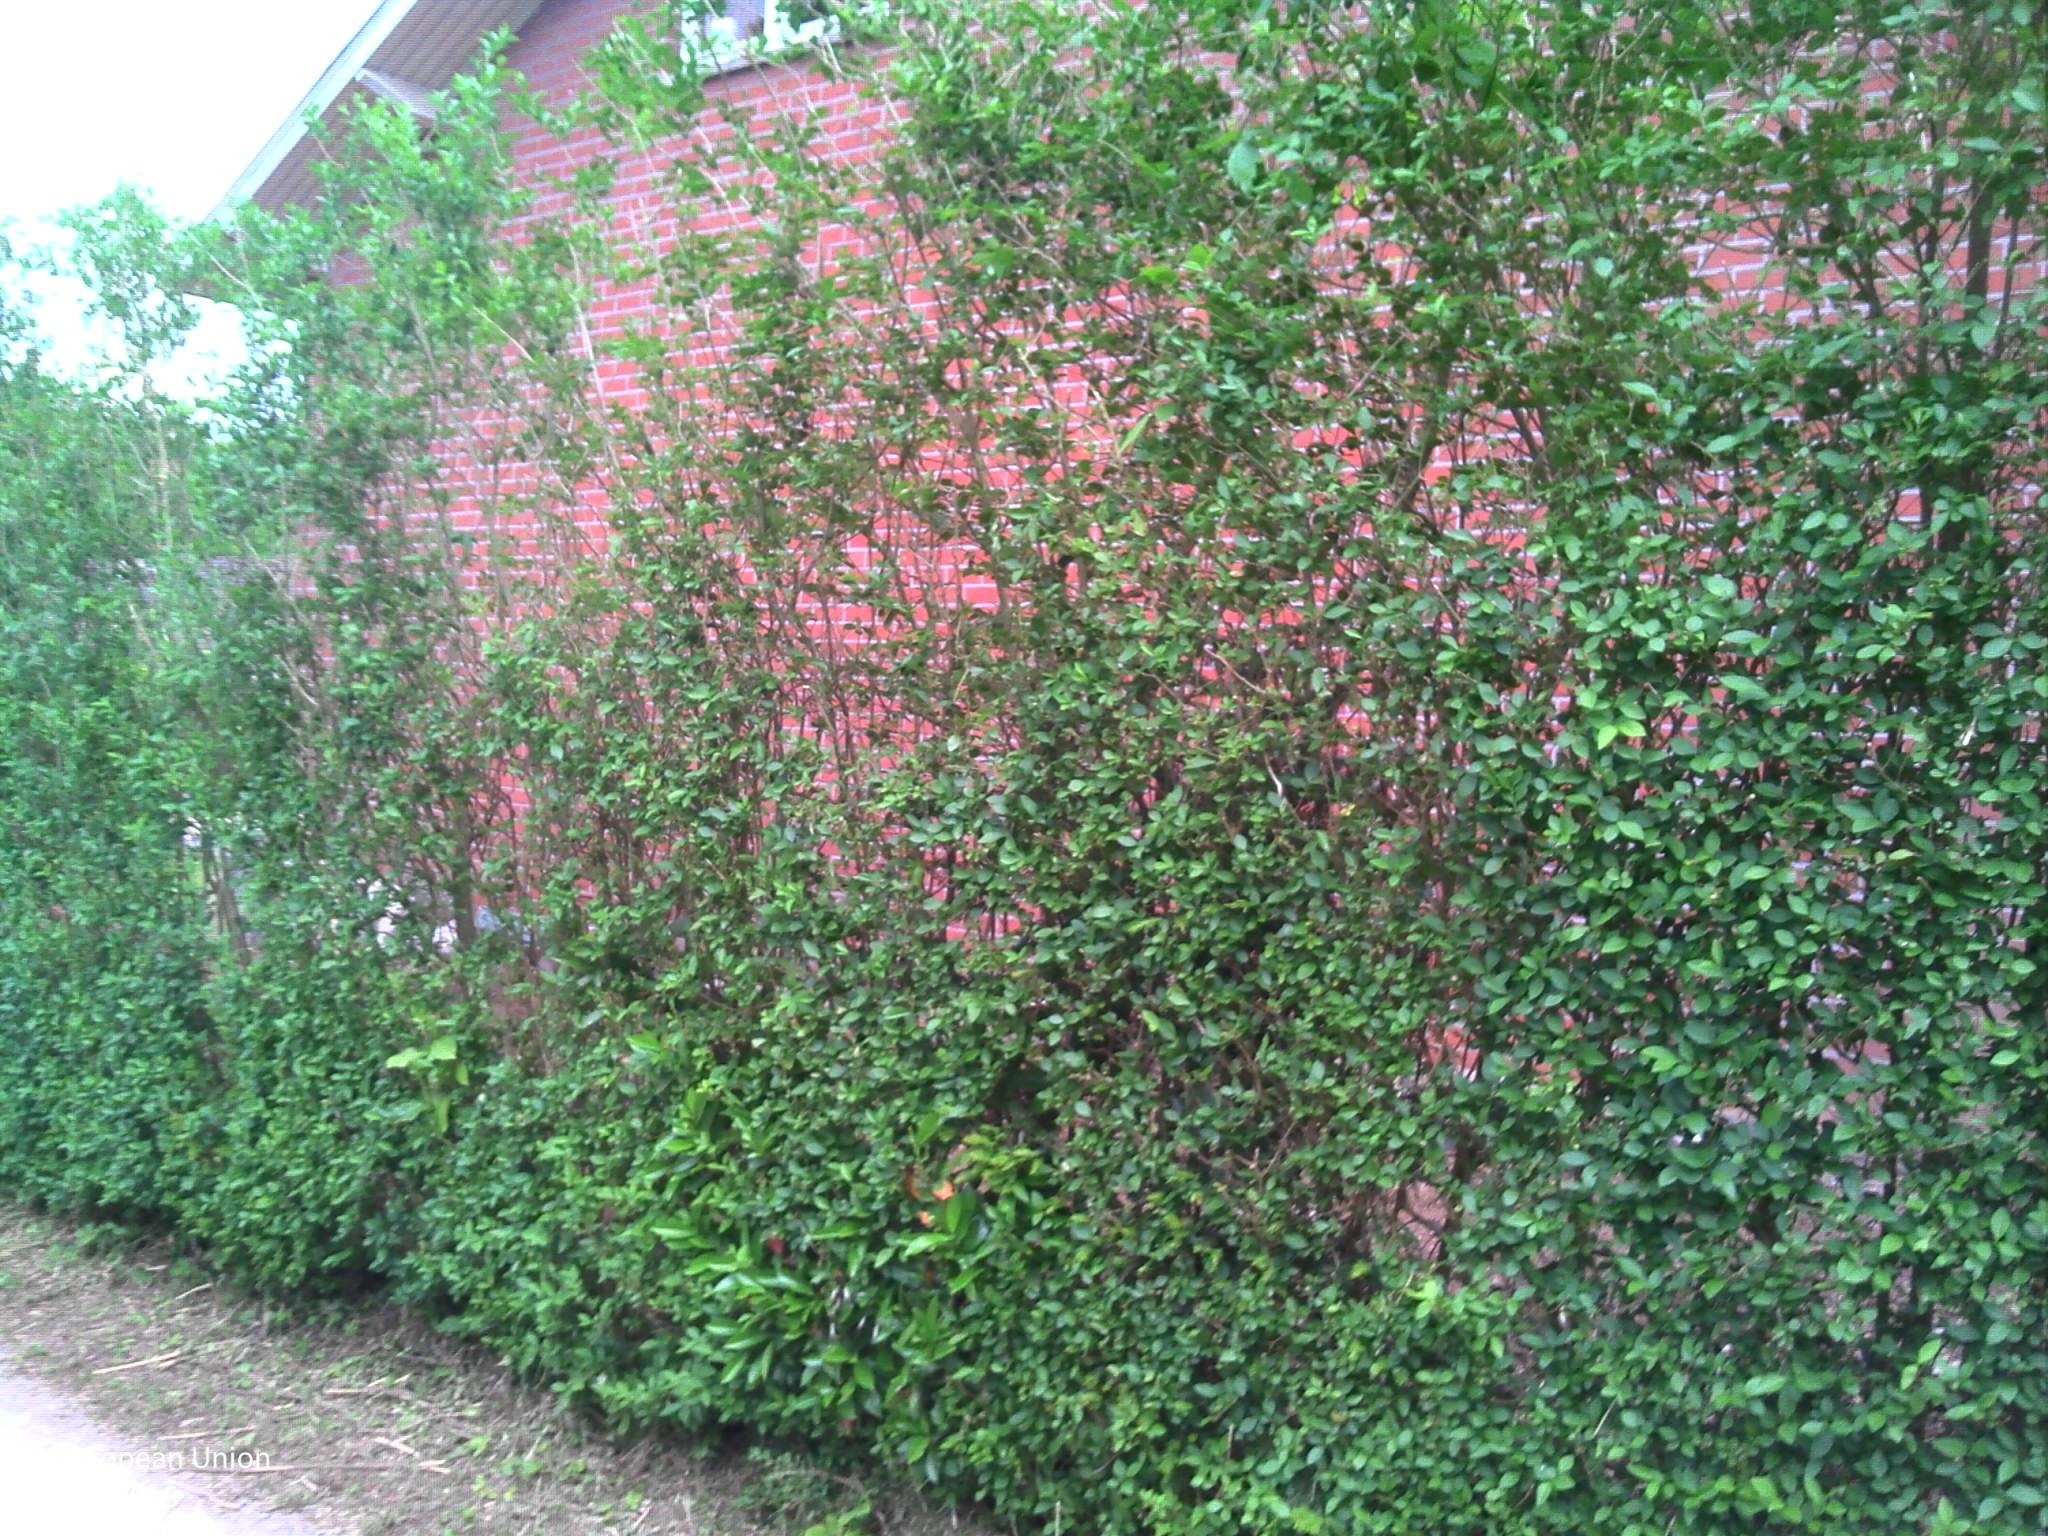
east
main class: Grassland
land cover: Grassland with sparse tree/shrub cover
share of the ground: > 75 %
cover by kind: herbaceous plants 95 %, broadleaved forest trees 5 %
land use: Residential
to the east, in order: Grassland with sparse tree/shrub cover; Artificial constructions in urban areas
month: May
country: BE
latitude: 50.7177
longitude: 4.4861
